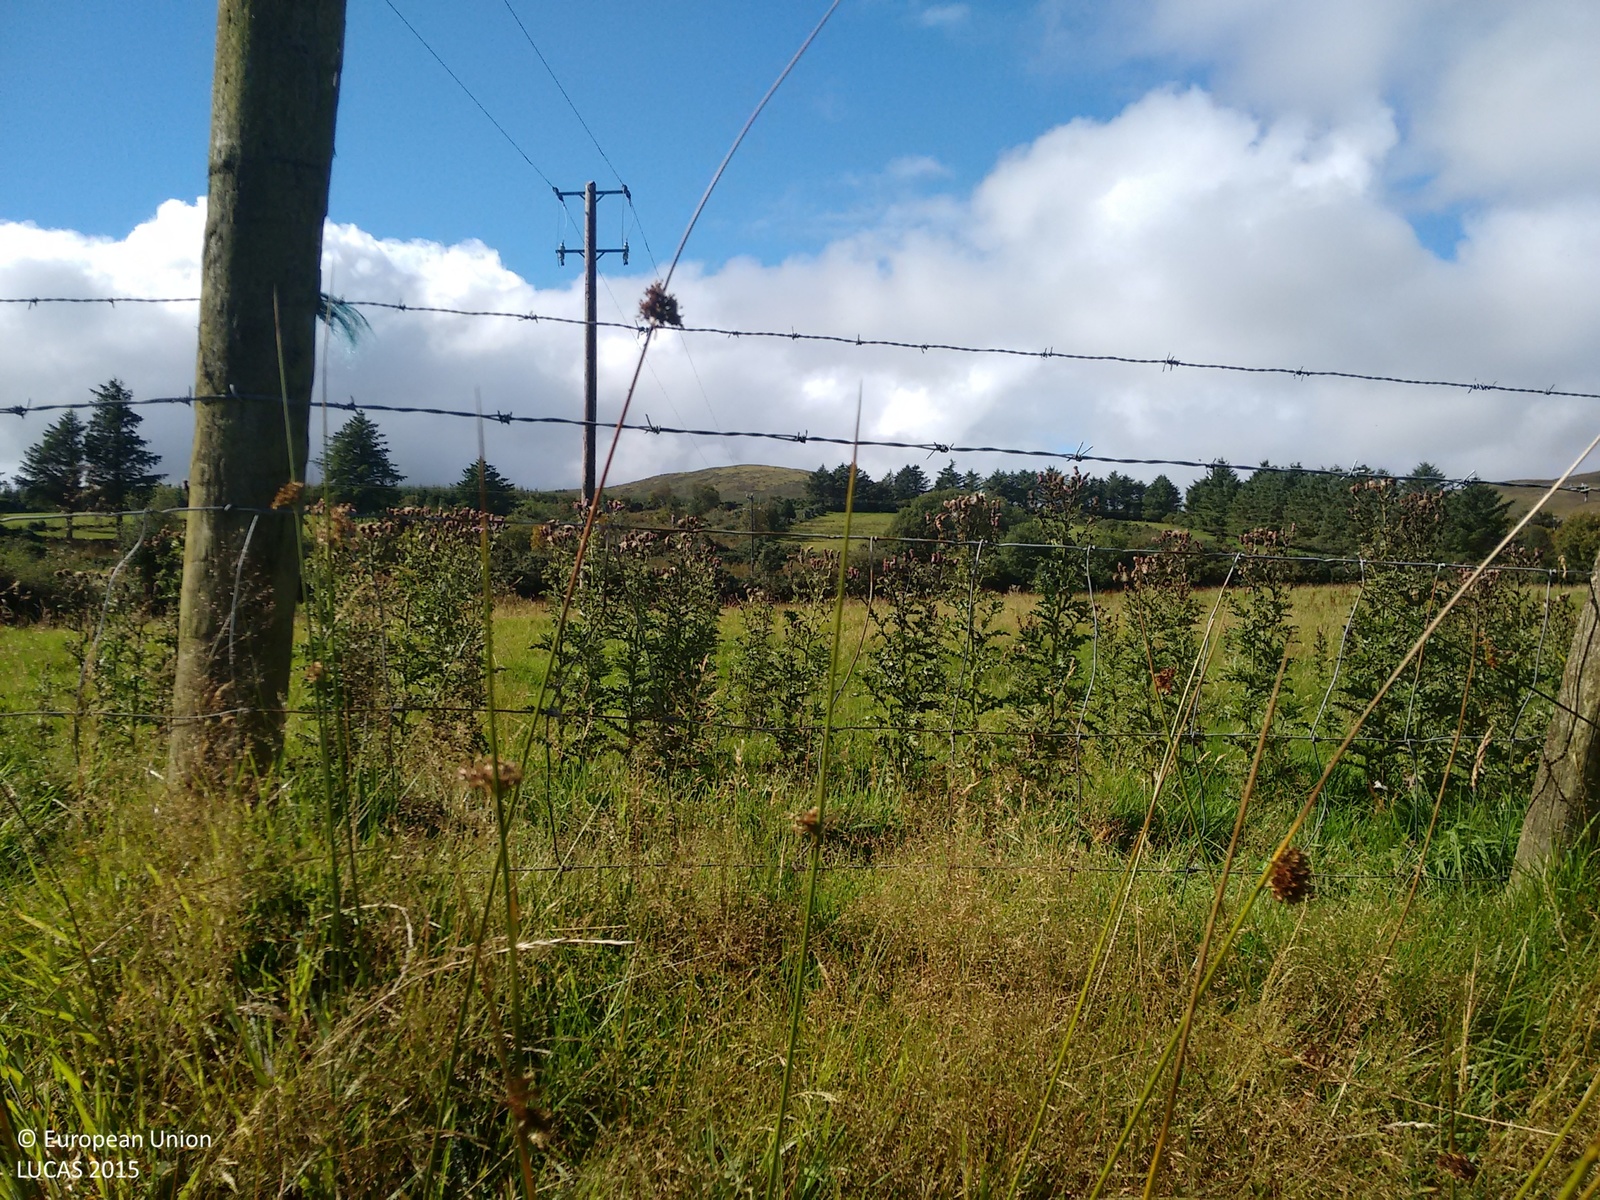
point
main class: Grassland
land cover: Grassland without tree/shrub cover
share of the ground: > 75 %
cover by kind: herbaceous plants 100 %
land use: Agriculture (excluding fallow land and kitchen gardens)
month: September
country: IE
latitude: 55.1379
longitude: -7.2276
